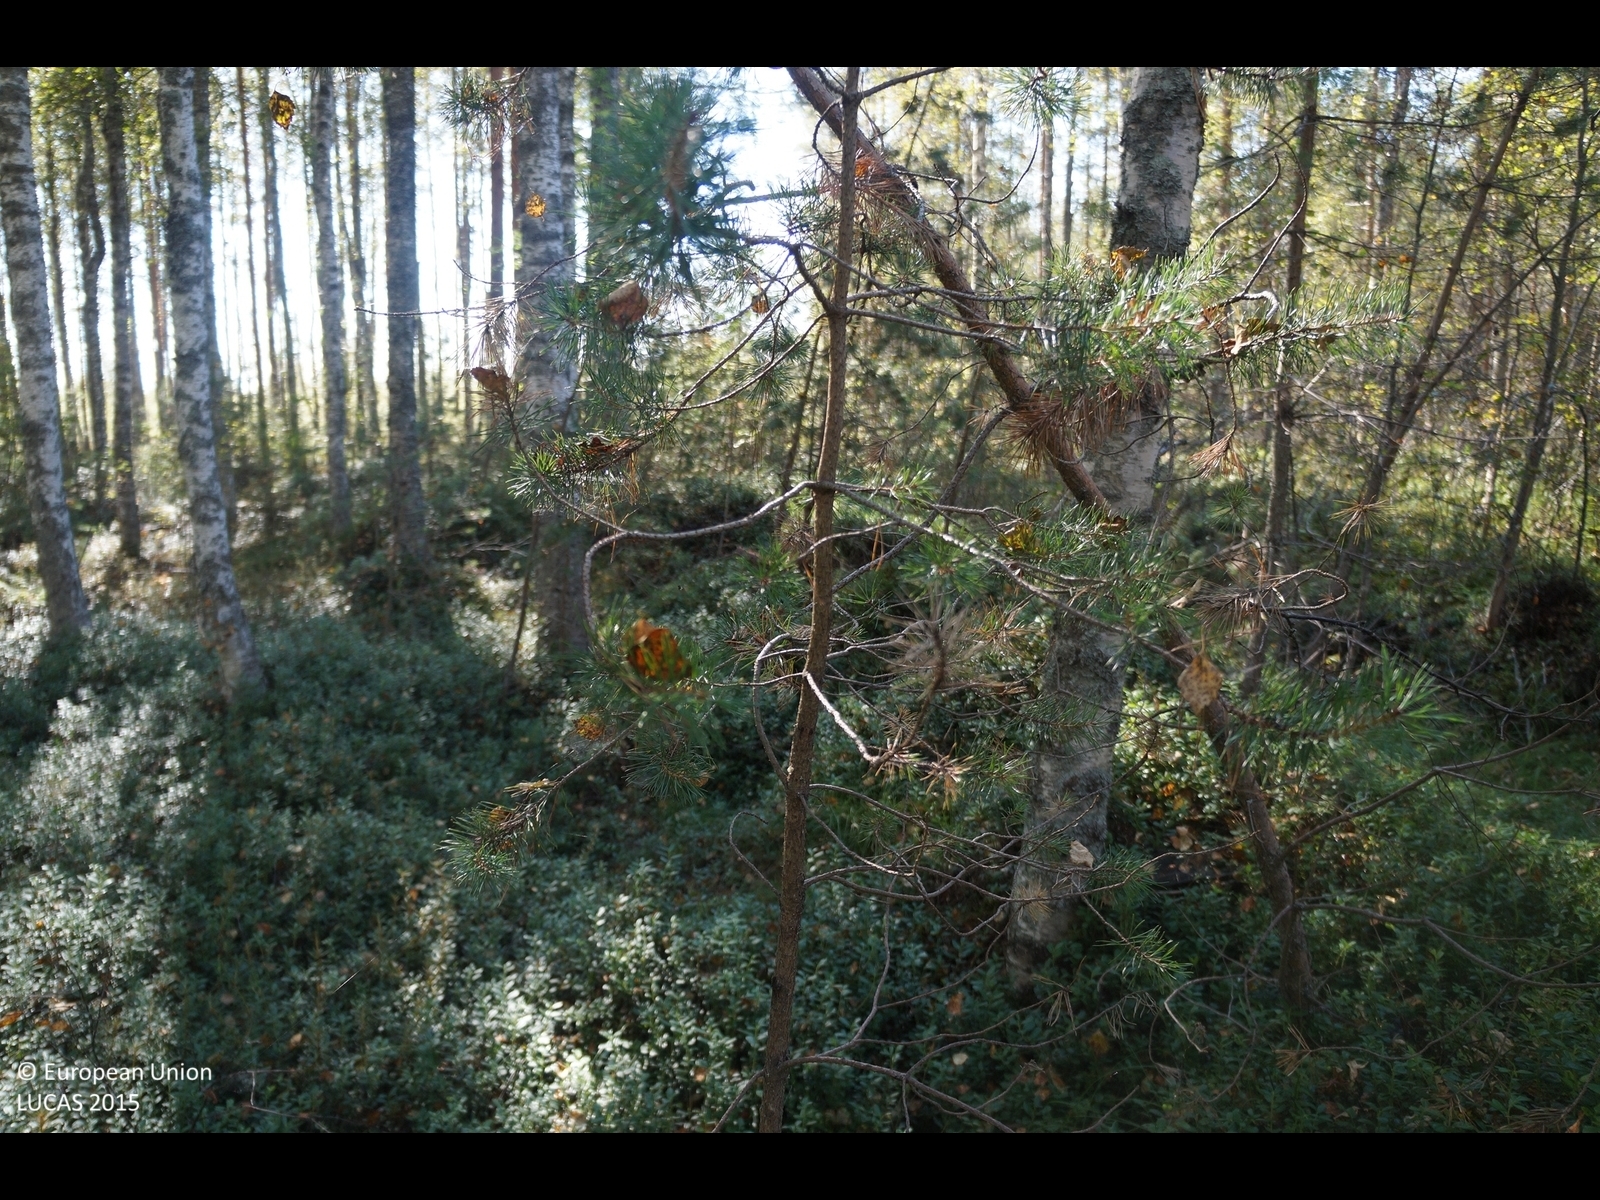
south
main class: Woodland
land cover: Broadleaved woodland
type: boreal forest
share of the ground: 50 - 75 %
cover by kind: broadleaved forest trees 65 %, shrubs 20 %, coniferous forest trees 5 %, herbaceous plants 5 %, lichens and mosses 5 %
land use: Forestry
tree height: > 5 m
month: August
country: FI
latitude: 64.3805
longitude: 25.1954
